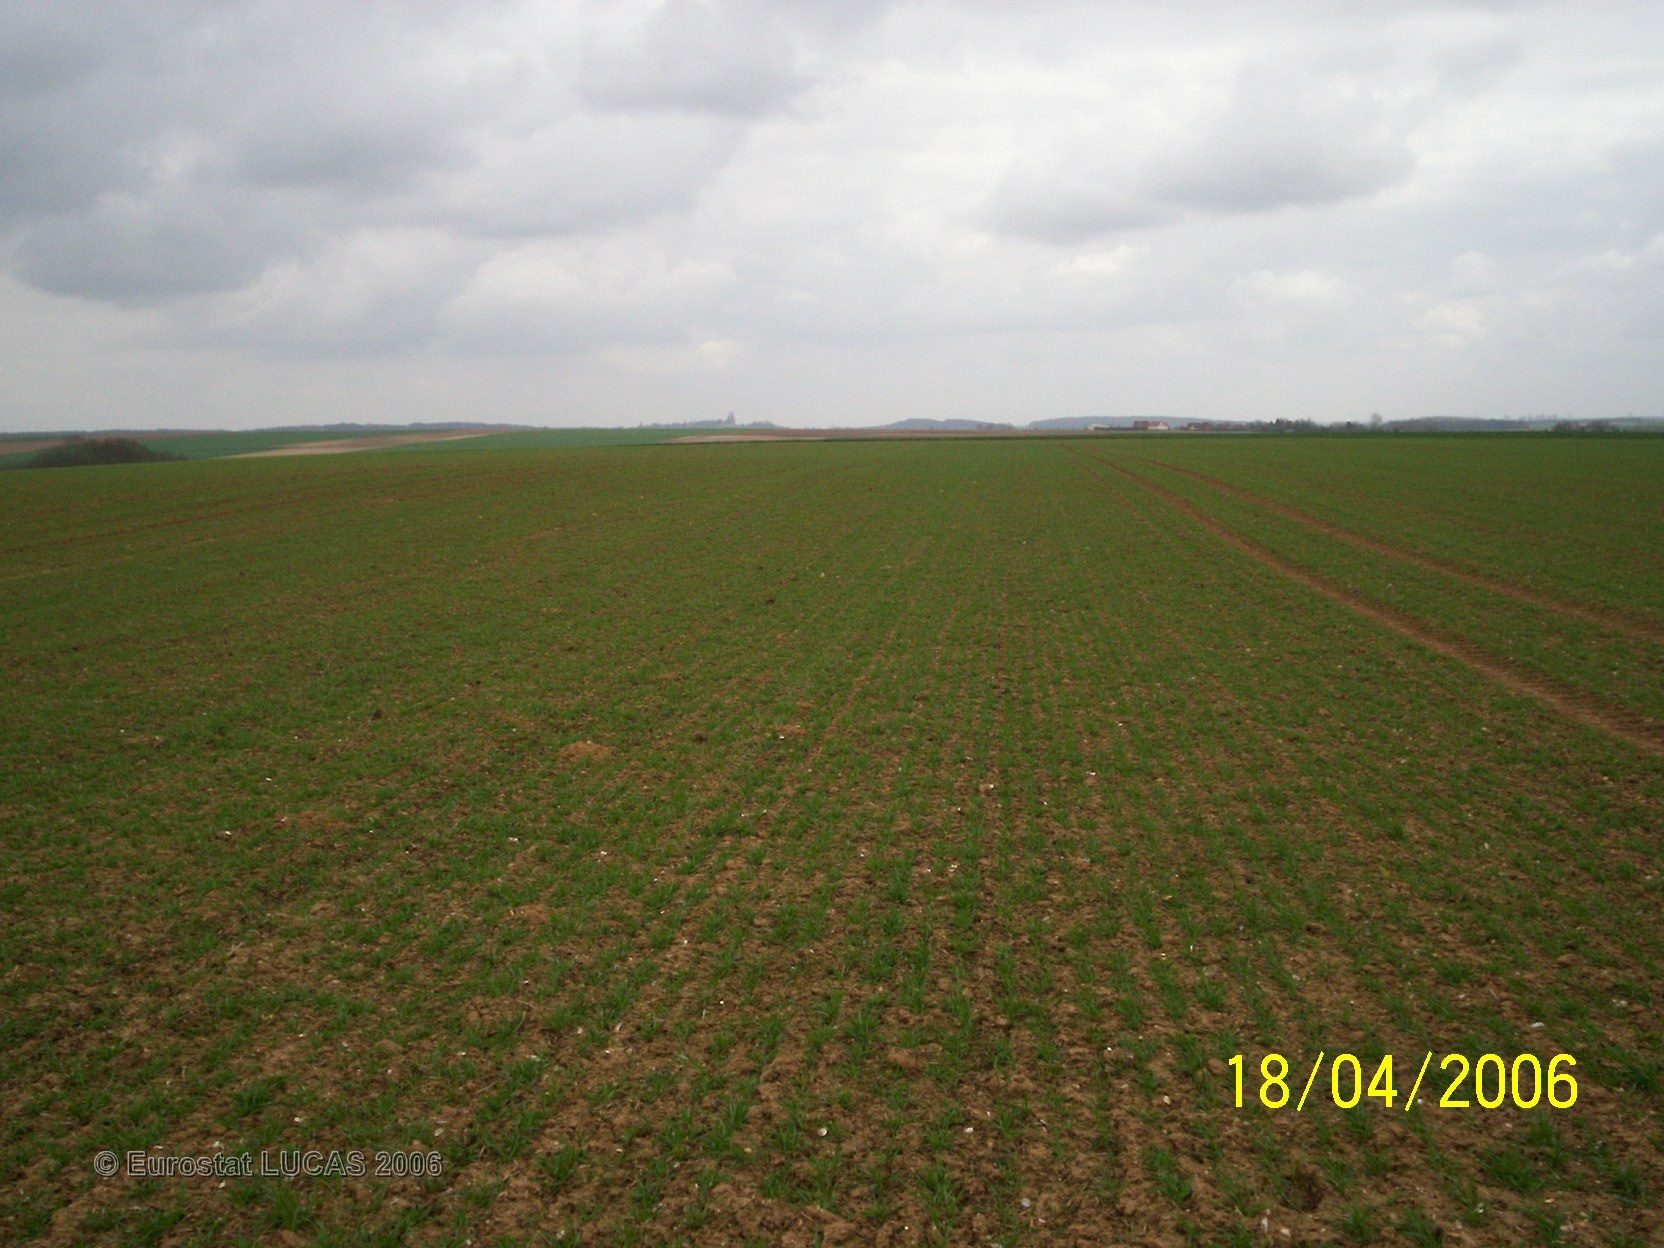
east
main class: Cropland
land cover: Common wheat
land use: Agriculture (excluding fallow land and kitchen gardens)
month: April
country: FR
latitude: 50.3595
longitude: 2.6083
